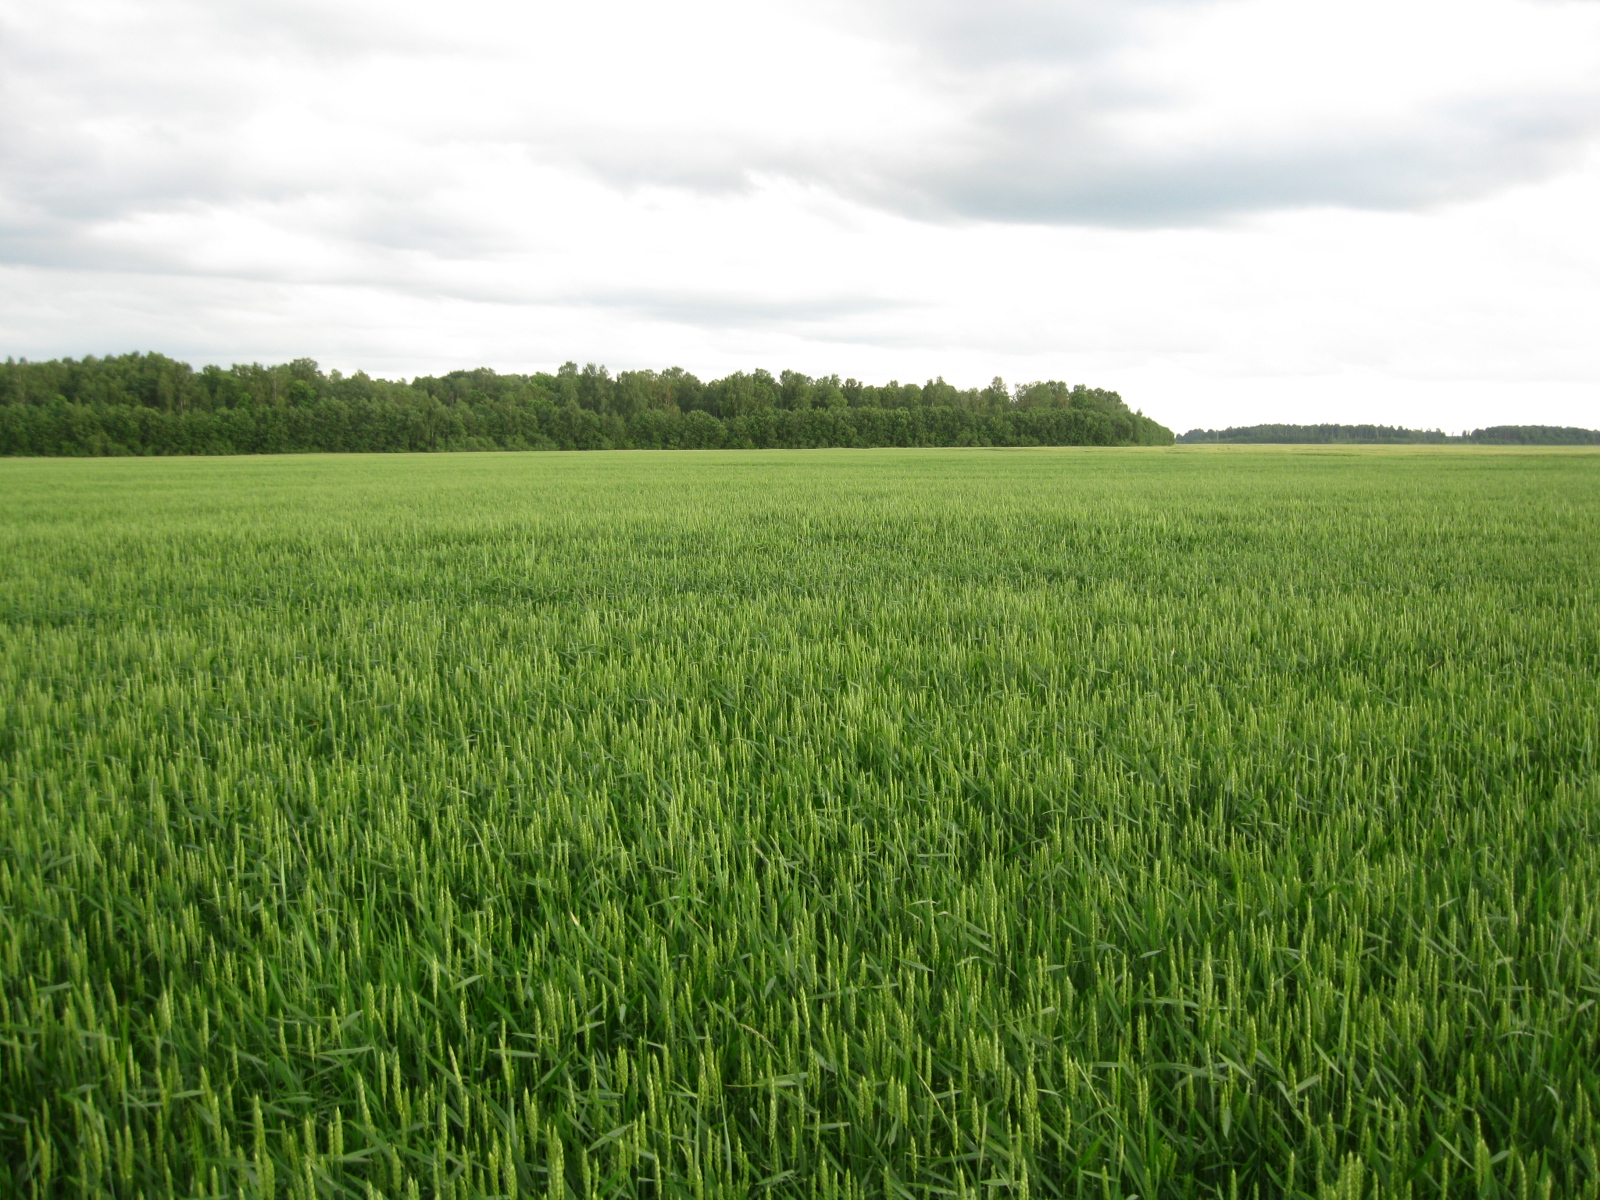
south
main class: Cropland
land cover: Common wheat
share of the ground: > 75 %
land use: Agriculture (excluding fallow land and kitchen gardens)
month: June
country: LT
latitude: 55.4671
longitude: 24.1866
